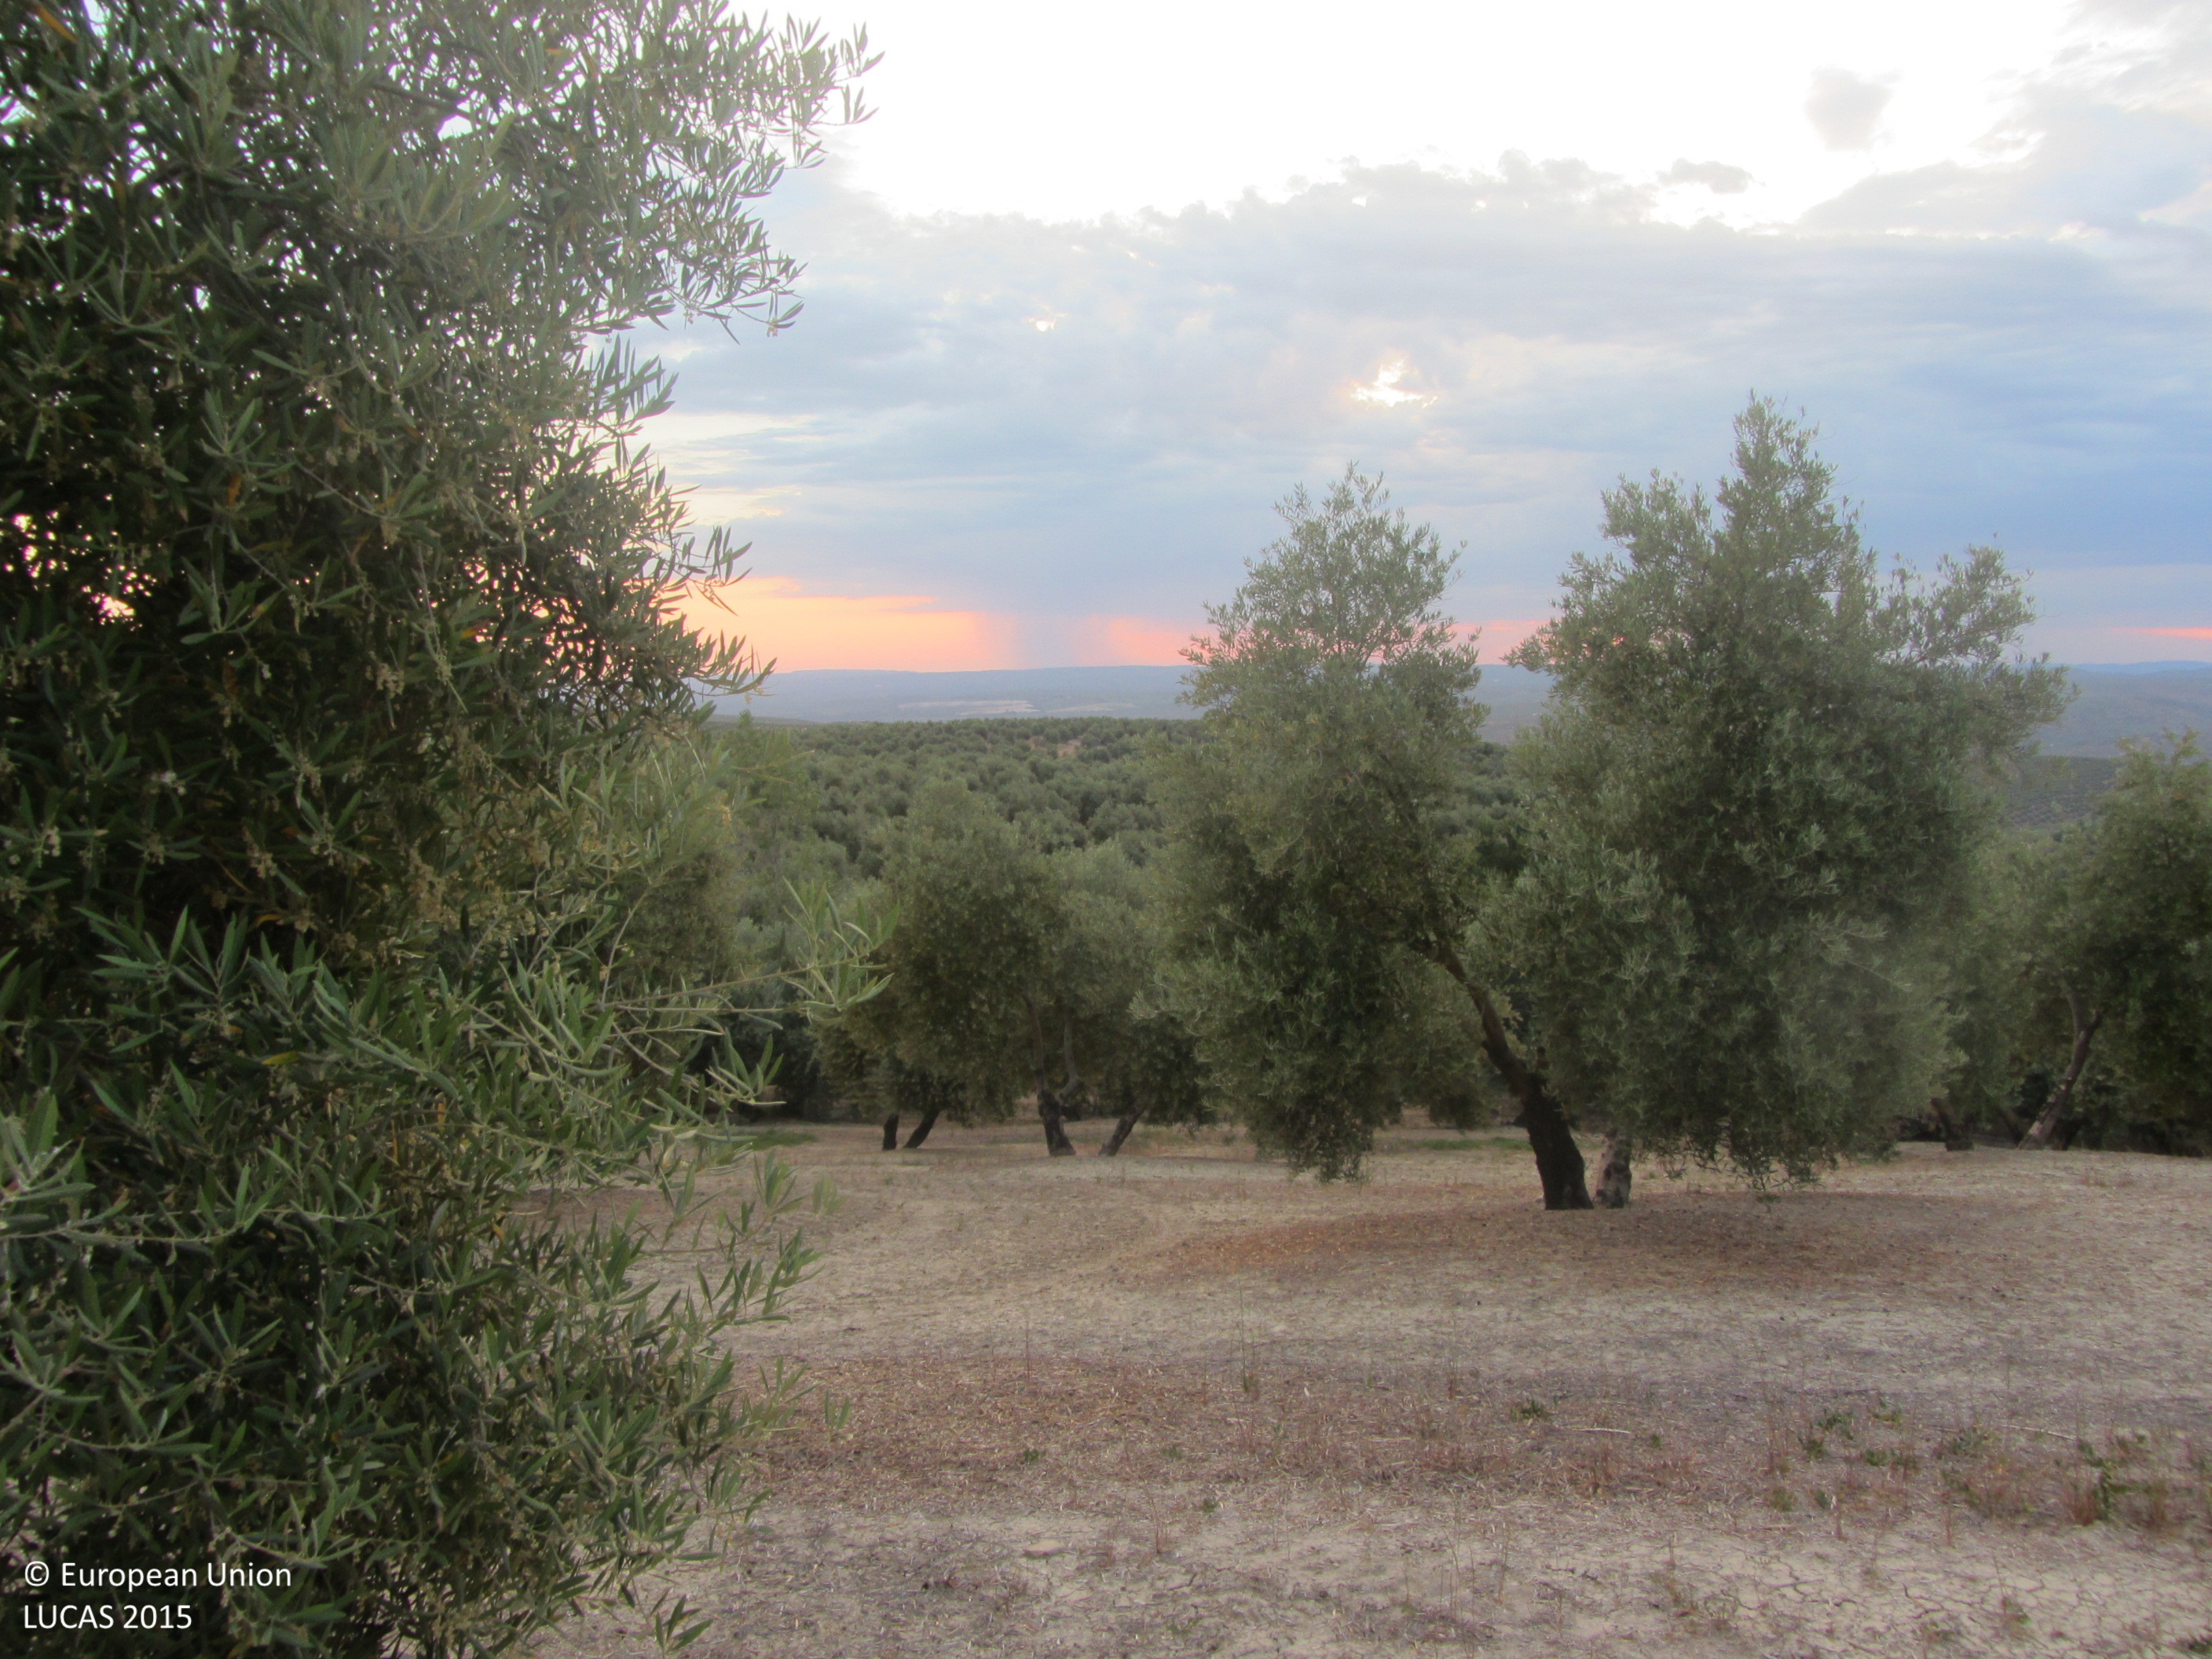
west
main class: Cropland
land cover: Olive groves
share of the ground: 25 - 50 %
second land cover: Other bare soil
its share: > 75 %
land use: Agriculture (excluding fallow land and kitchen gardens)
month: May
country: ES
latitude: 38.1651
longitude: -3.0449
